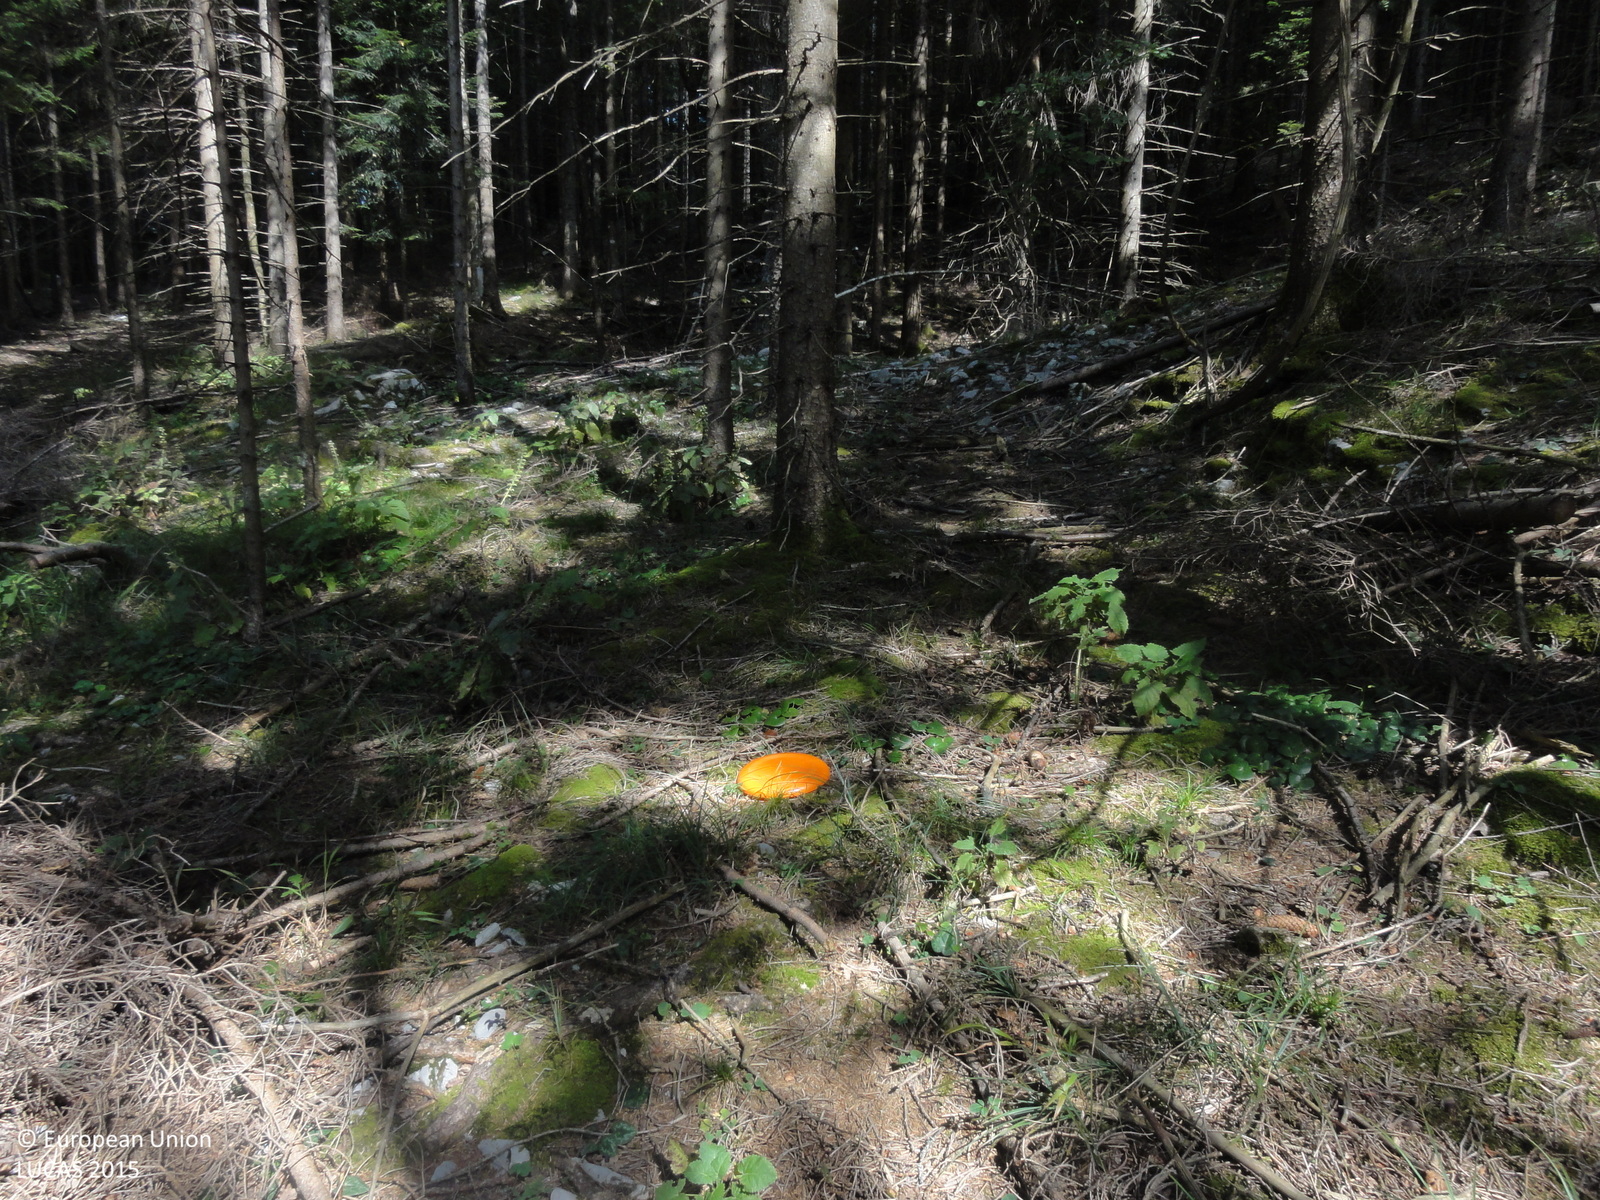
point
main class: Woodland
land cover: Spruce dominated coniferous woodland
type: hemiboreal forest and nemoral coniferous forest and mixed broadleaved-coniferous forest
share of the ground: > 75 %
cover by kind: coniferous forest trees 85 %, unconsolidated bare surface 10 %, broadleaved forest trees 5 %
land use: Forestry
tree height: > 5 m
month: September
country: SI
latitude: 45.7280
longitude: 15.0204
